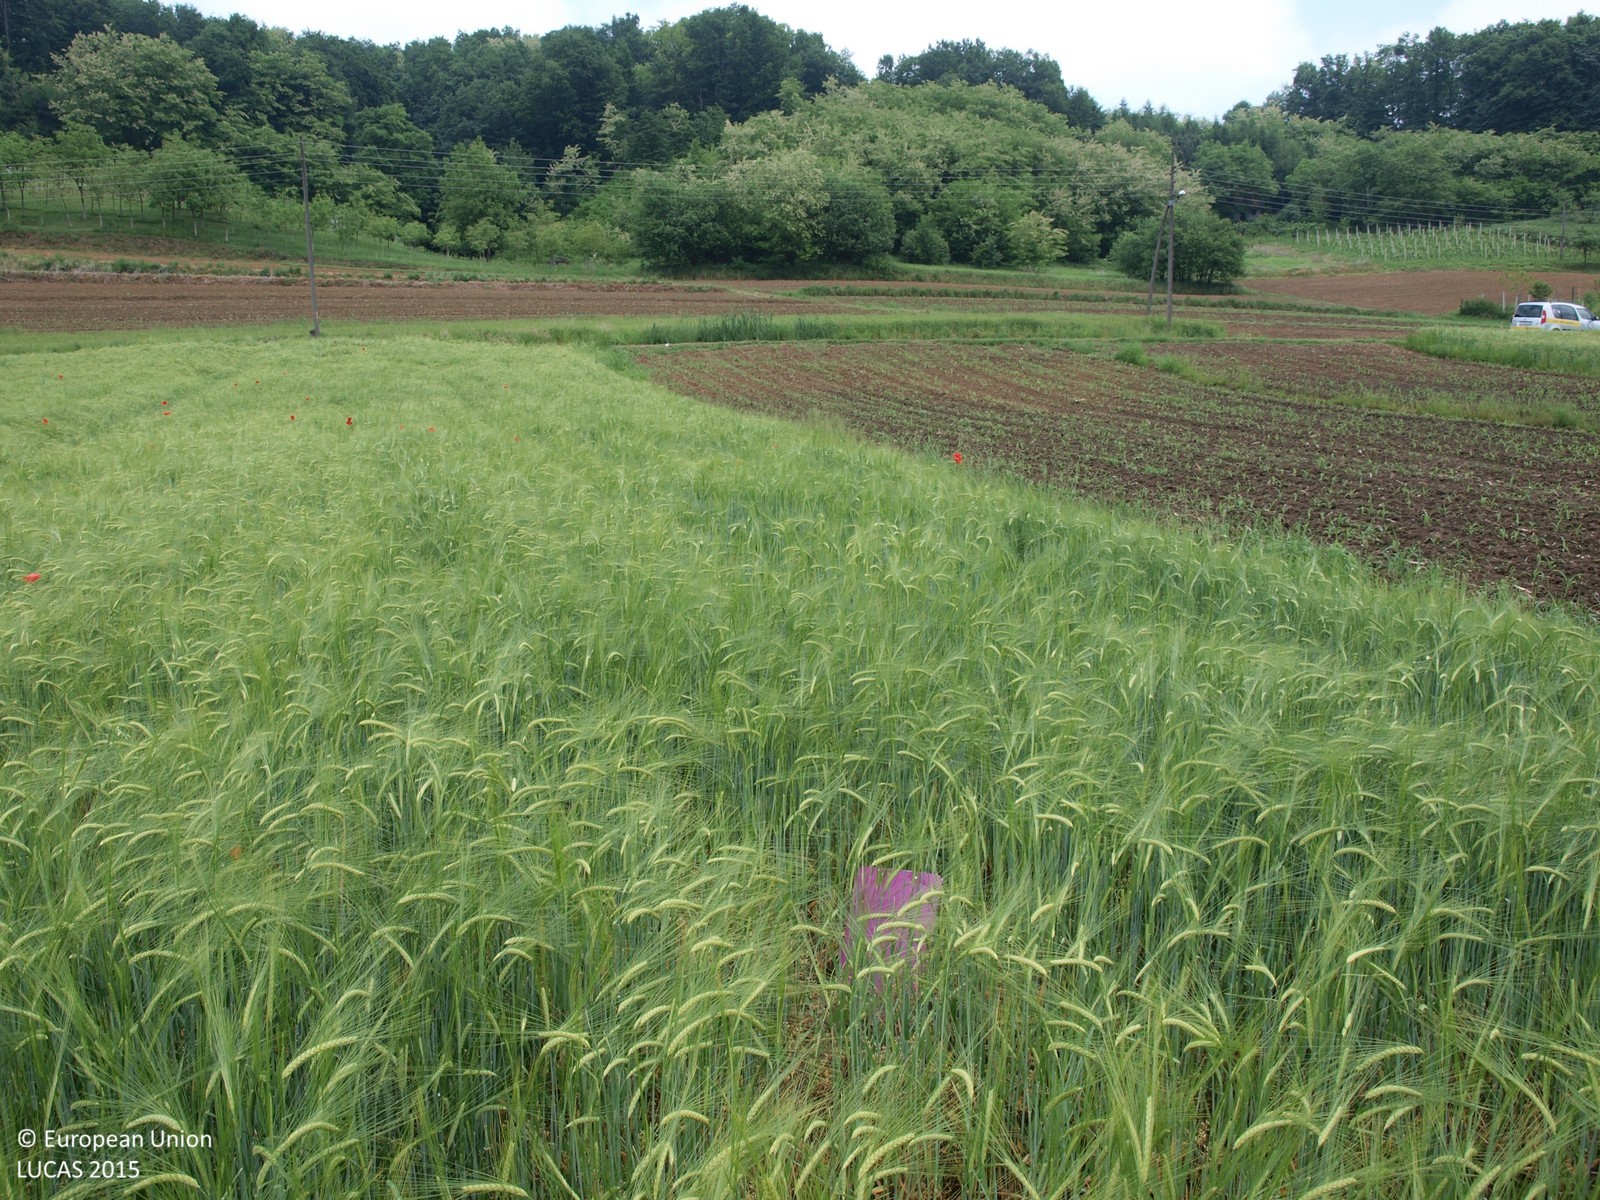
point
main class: Cropland
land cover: Barley
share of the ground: > 75 %
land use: Agriculture (excluding fallow land and kitchen gardens)
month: May
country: HR
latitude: 46.2204
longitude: 16.2873
